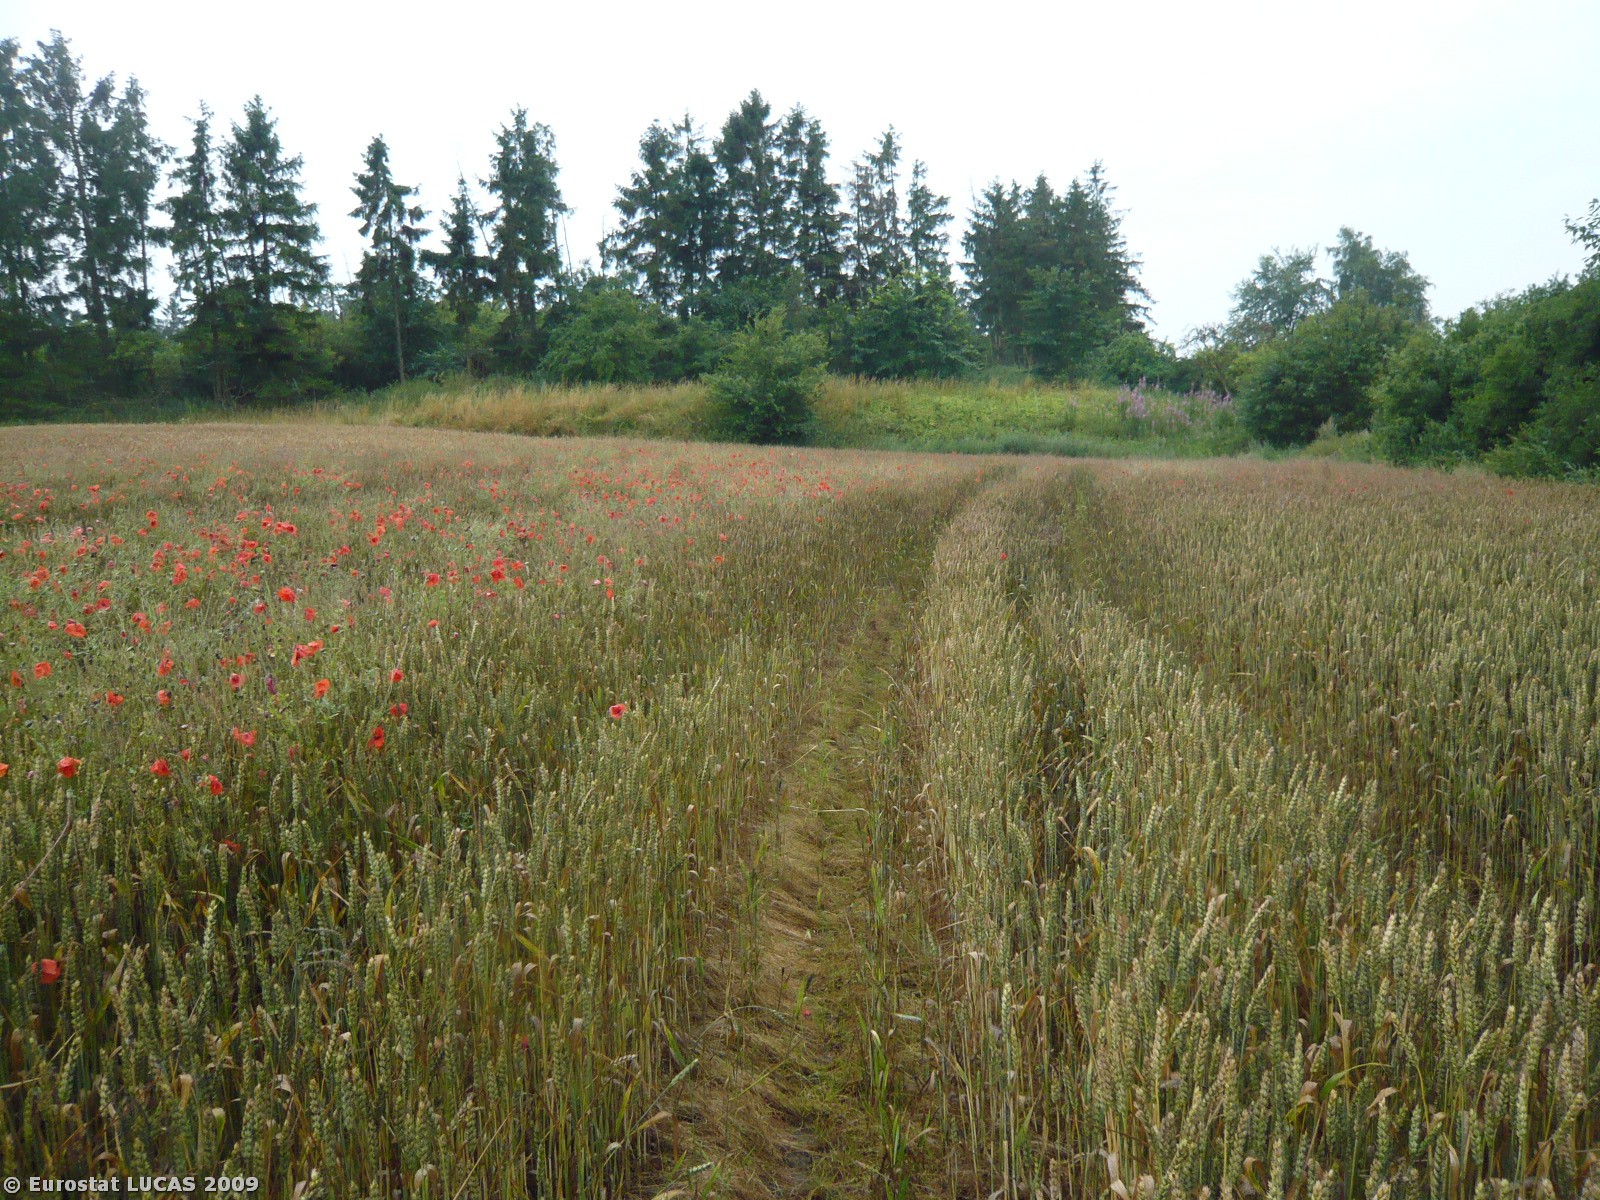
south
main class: Cropland
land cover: Common wheat
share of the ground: > 75 %
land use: Agriculture (excluding fallow land and kitchen gardens)
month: July
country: DK
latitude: 55.5657
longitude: 11.6635
